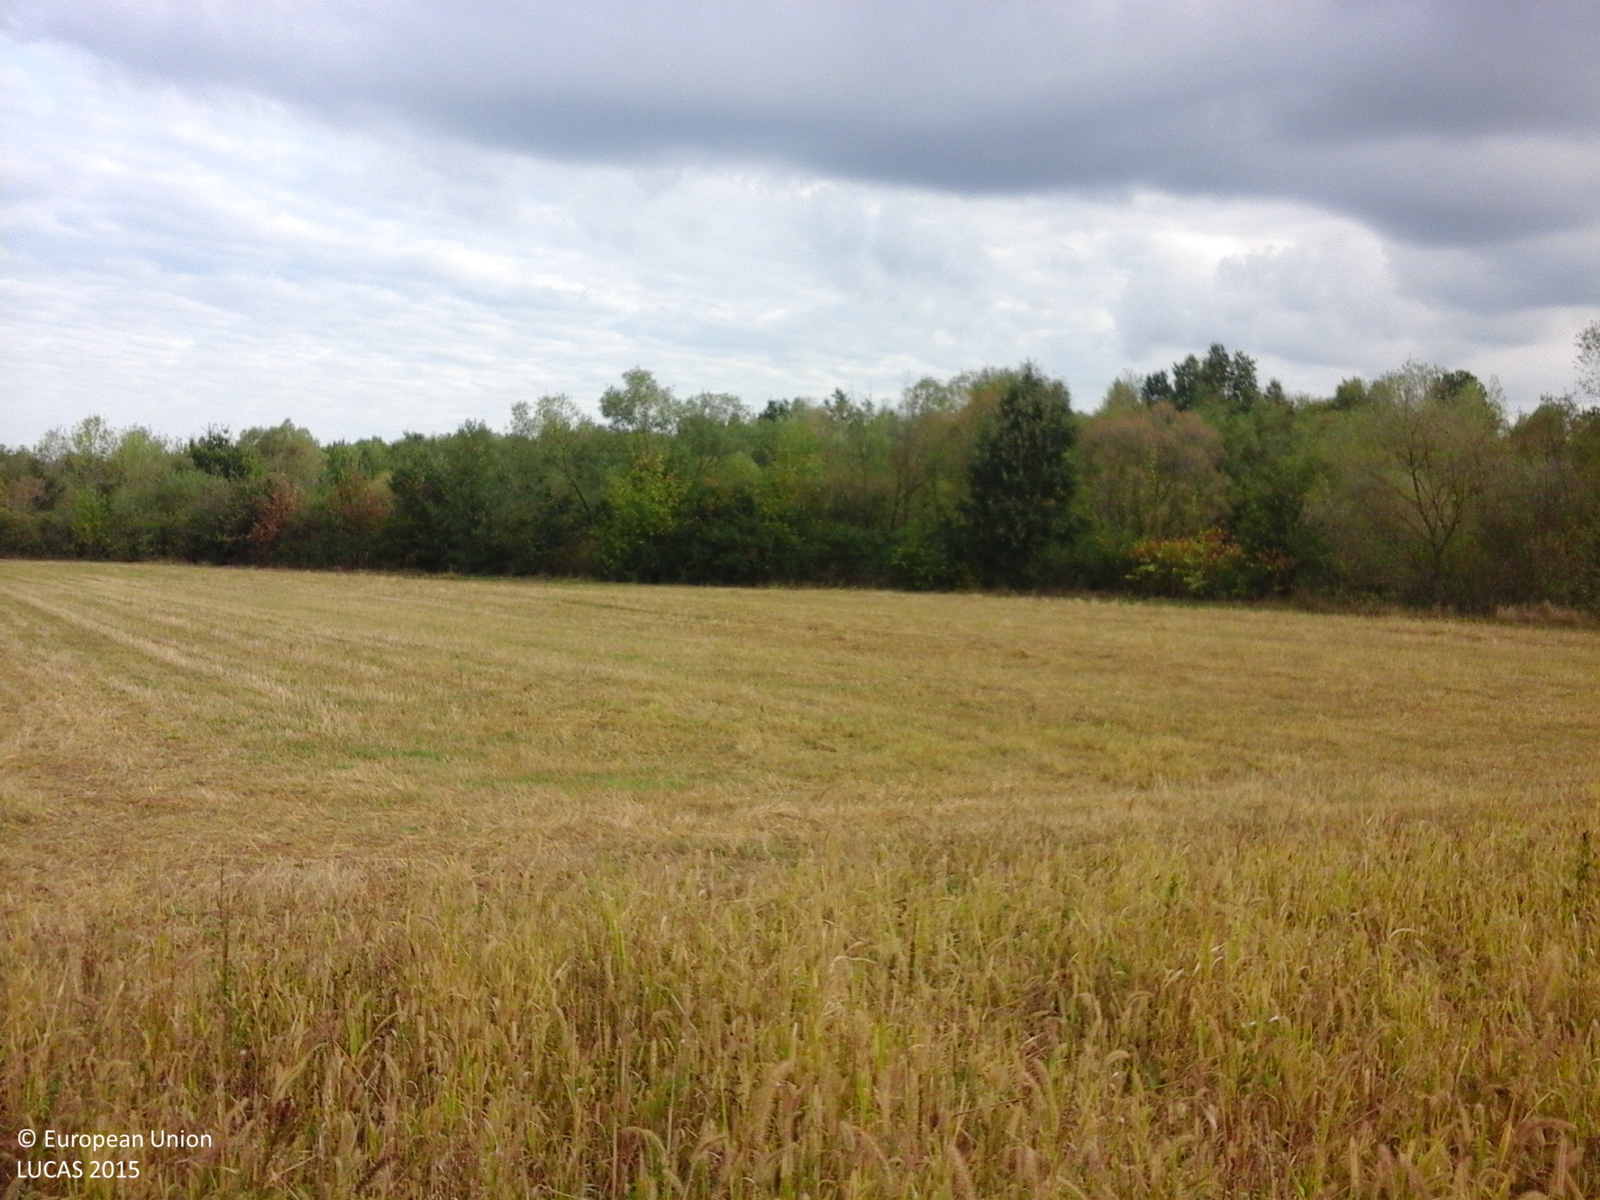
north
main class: Grassland
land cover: Grassland without tree/shrub cover
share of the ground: > 75 %
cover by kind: herbaceous plants 100 %
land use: Agriculture (excluding fallow land and kitchen gardens)
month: September
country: RO
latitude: 47.5934
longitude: 23.4656
